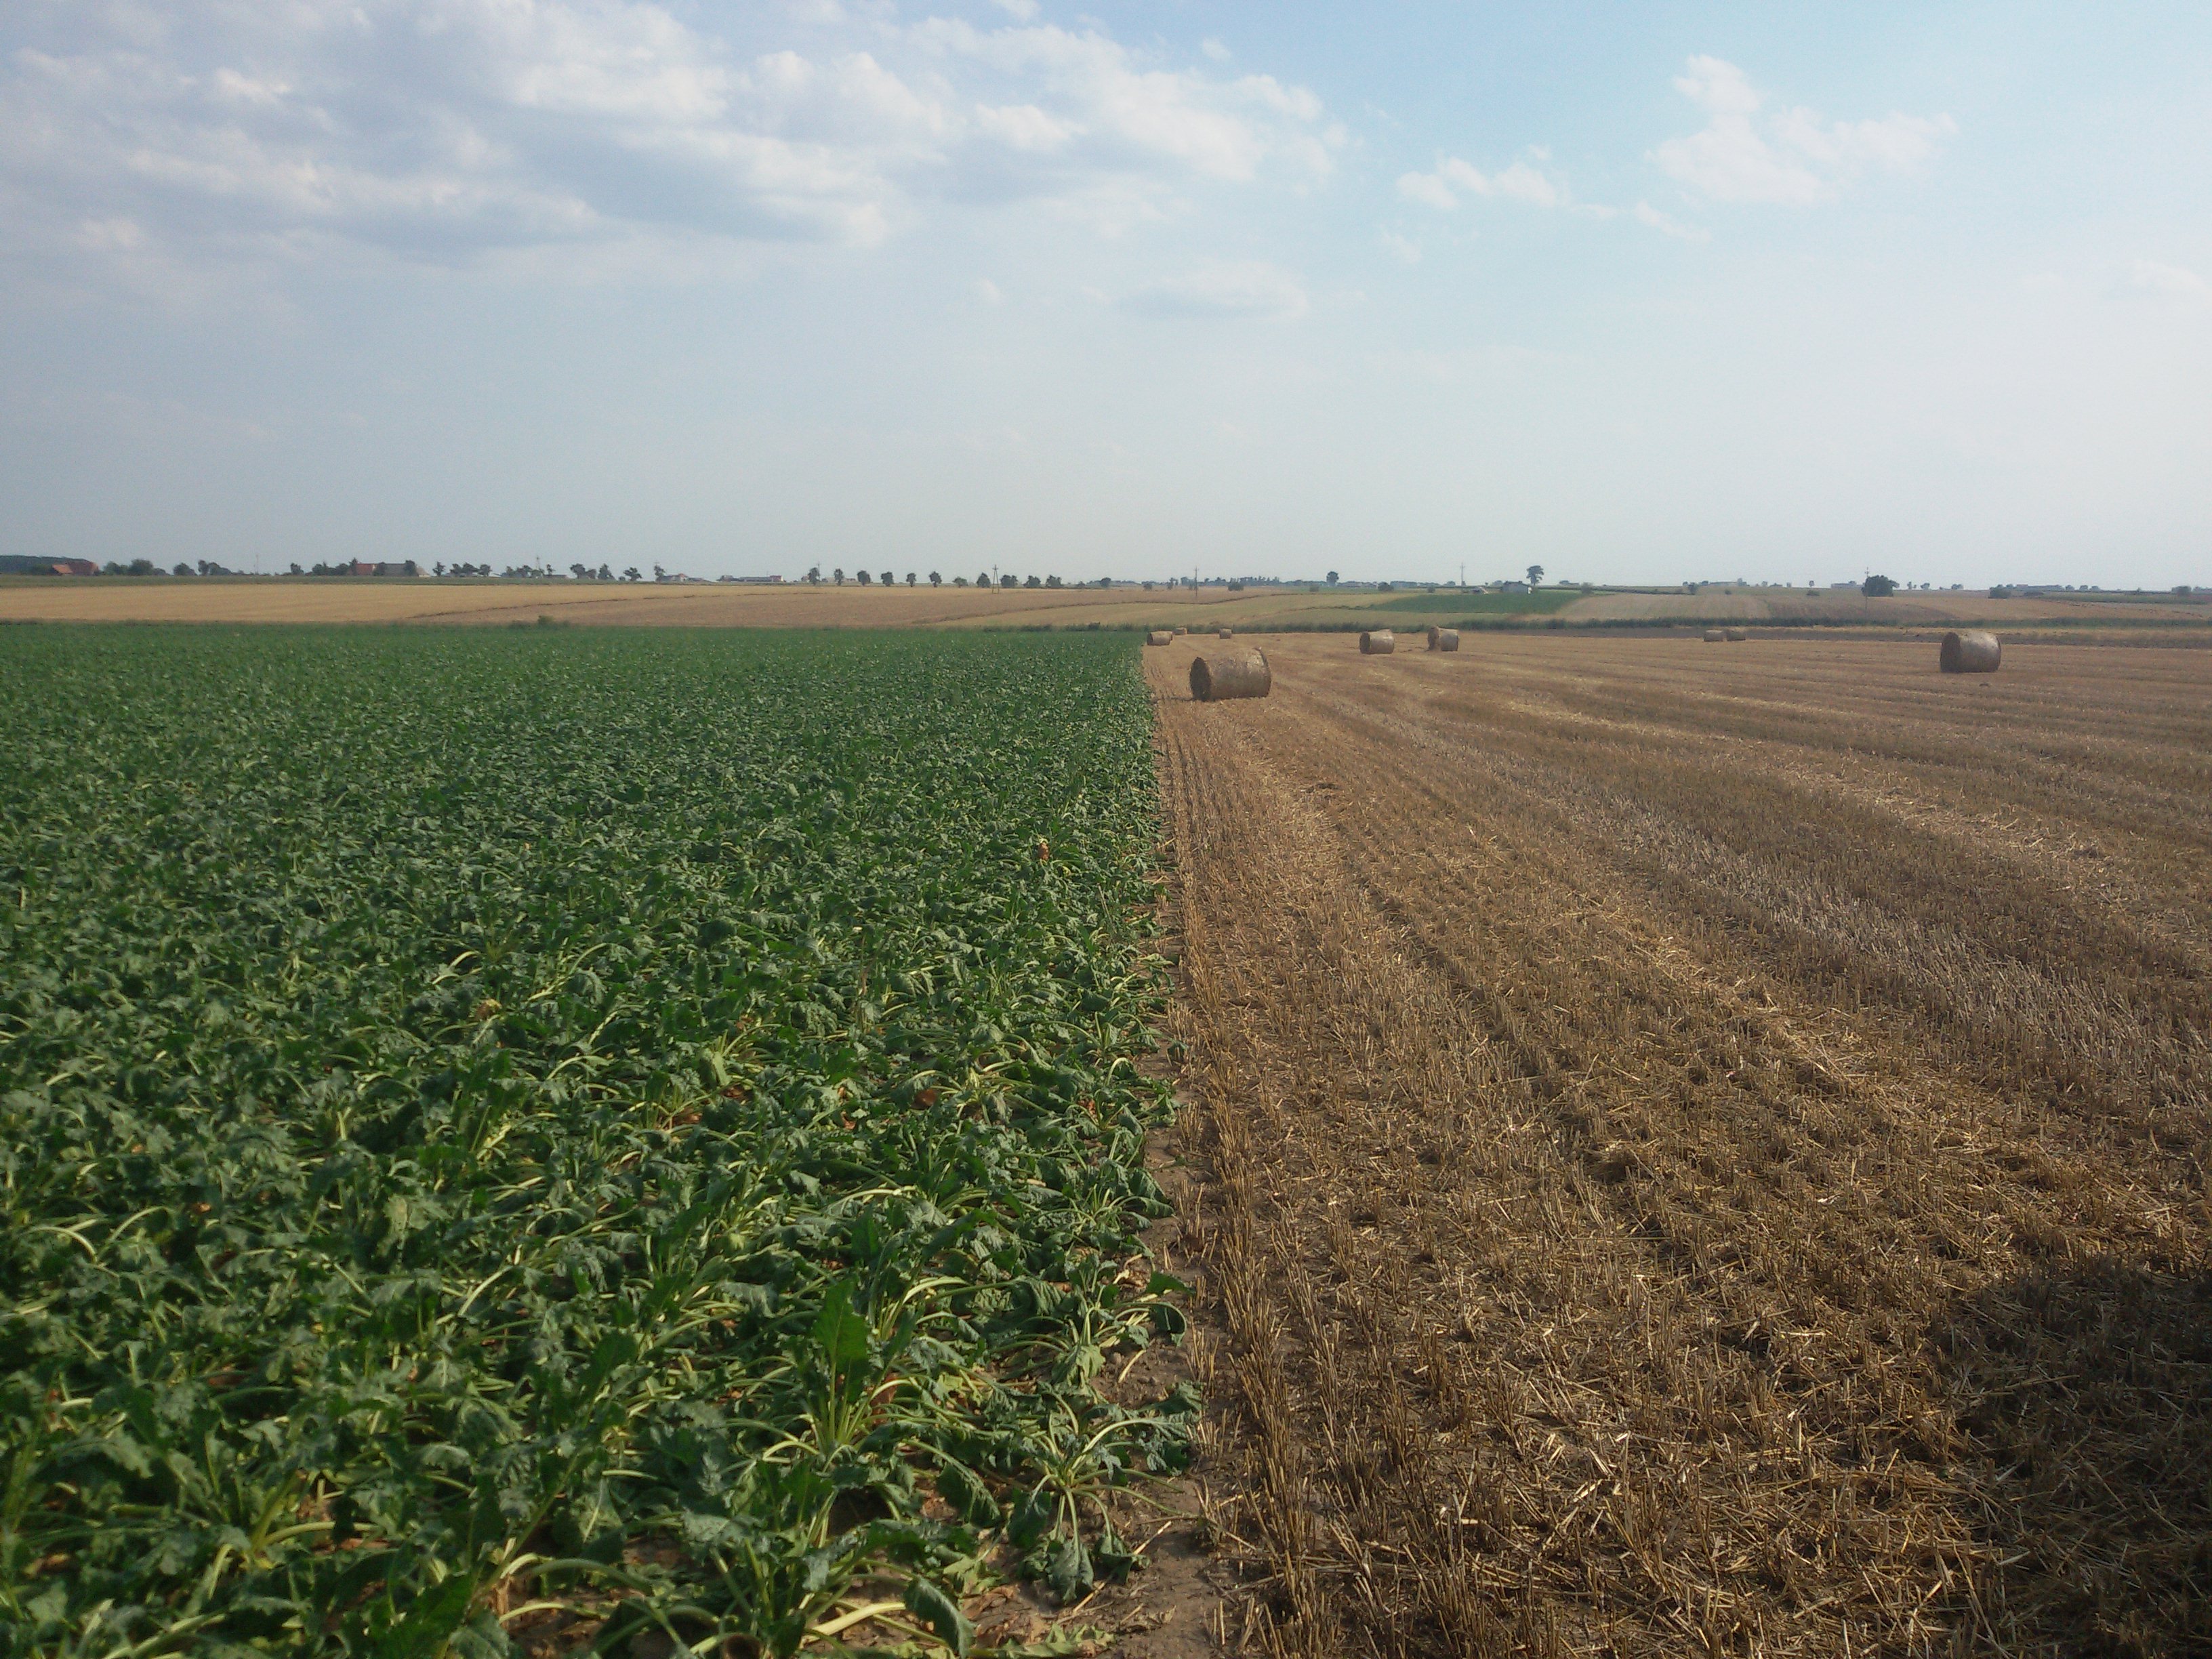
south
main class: Cropland
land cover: Sugar beet
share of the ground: > 75 %
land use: Agriculture (excluding fallow land and kitchen gardens)
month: August
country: PL
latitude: 51.8020
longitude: 17.4227
